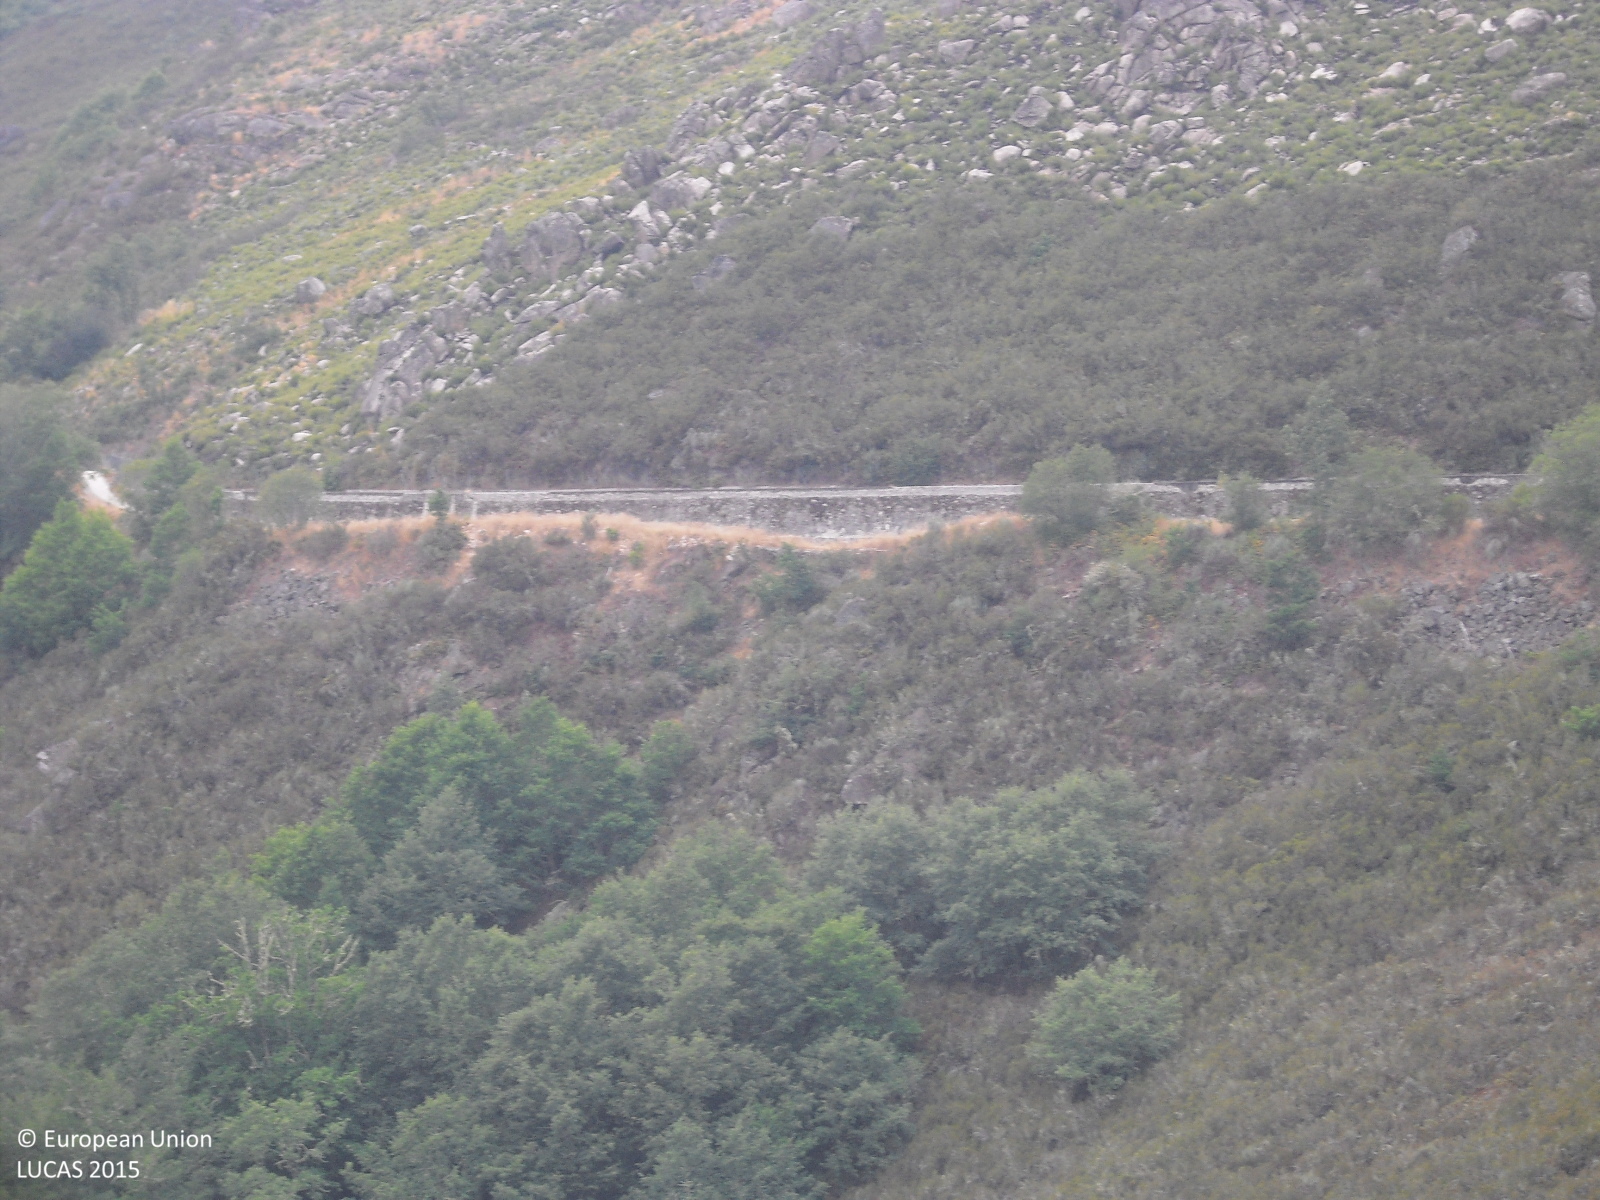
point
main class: Shrubland
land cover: Shrubland without tree cover
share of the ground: > 75 %
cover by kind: shrubs 100 %
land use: Semi-natural and natural areas not in use
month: July
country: ES
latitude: 42.2827
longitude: -7.3674
